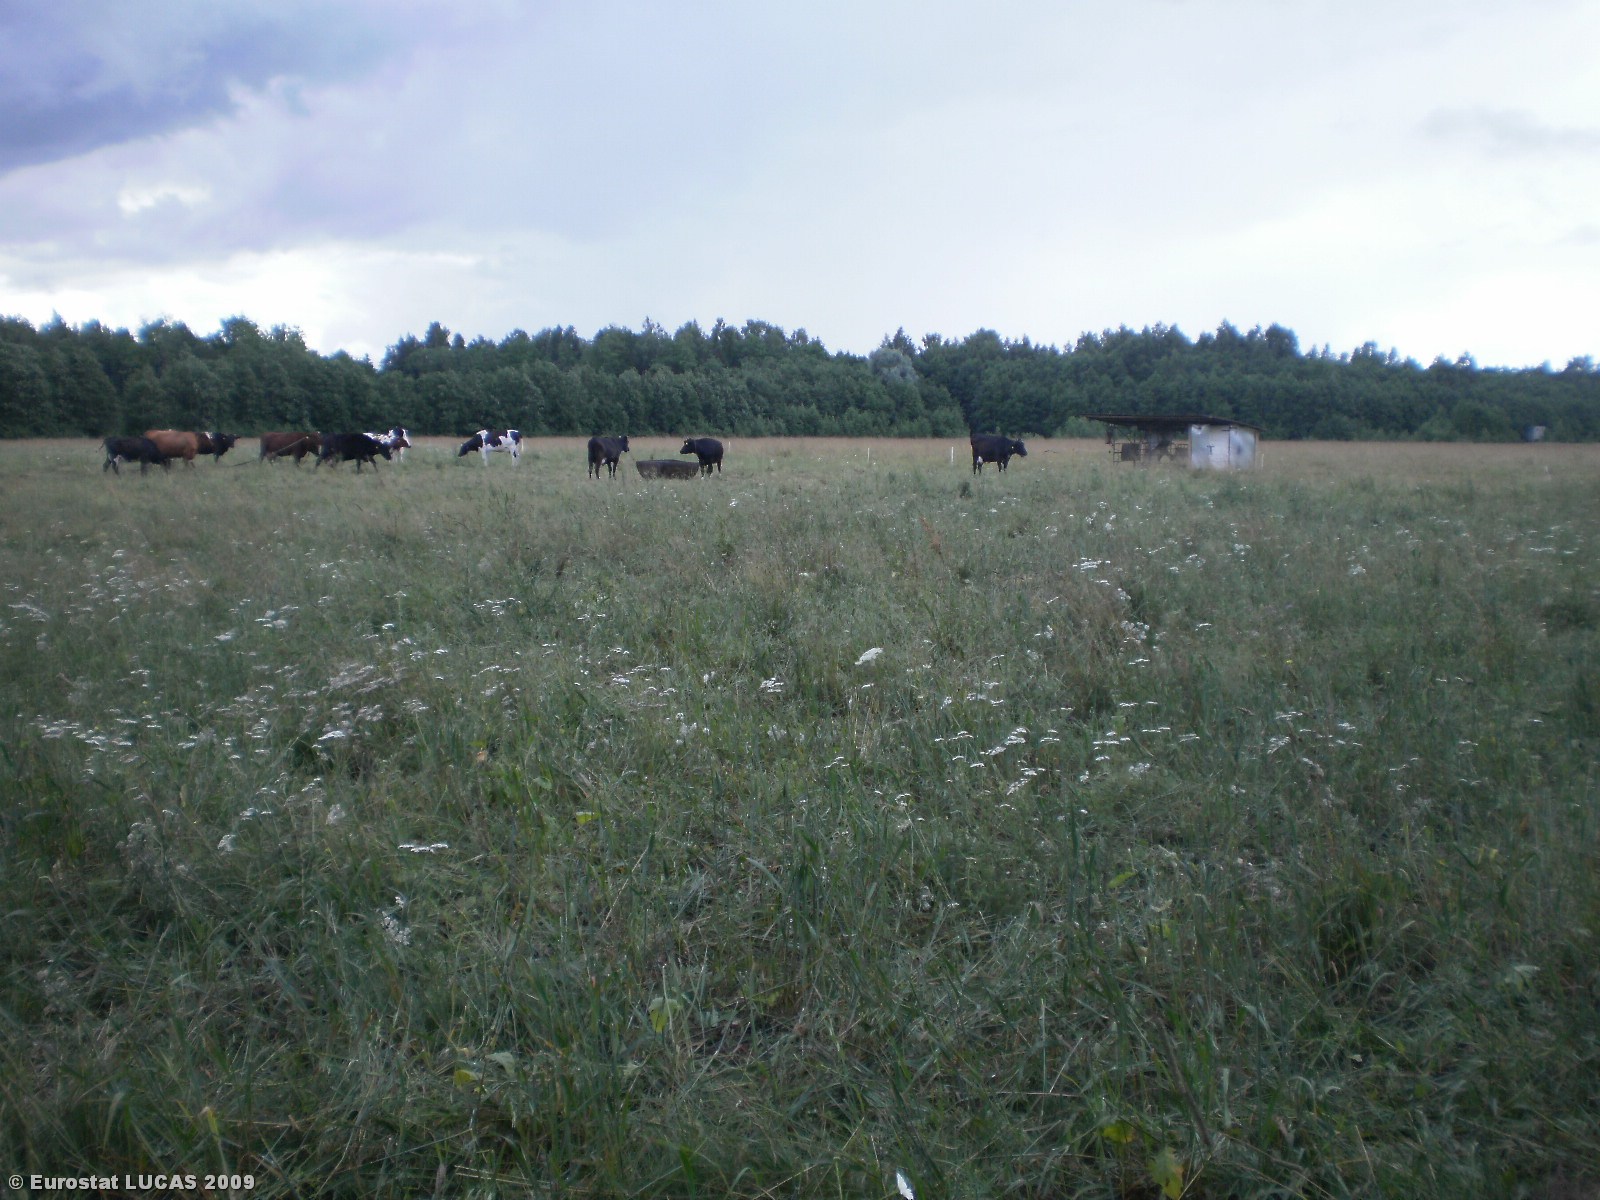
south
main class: Woodland
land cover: Broadleaved woodland
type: non-riverine alder, birch or aspen forest
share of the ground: > 75 %
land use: Forestry
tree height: > 5 m
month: July
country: LT
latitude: 56.0234
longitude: 24.9168
